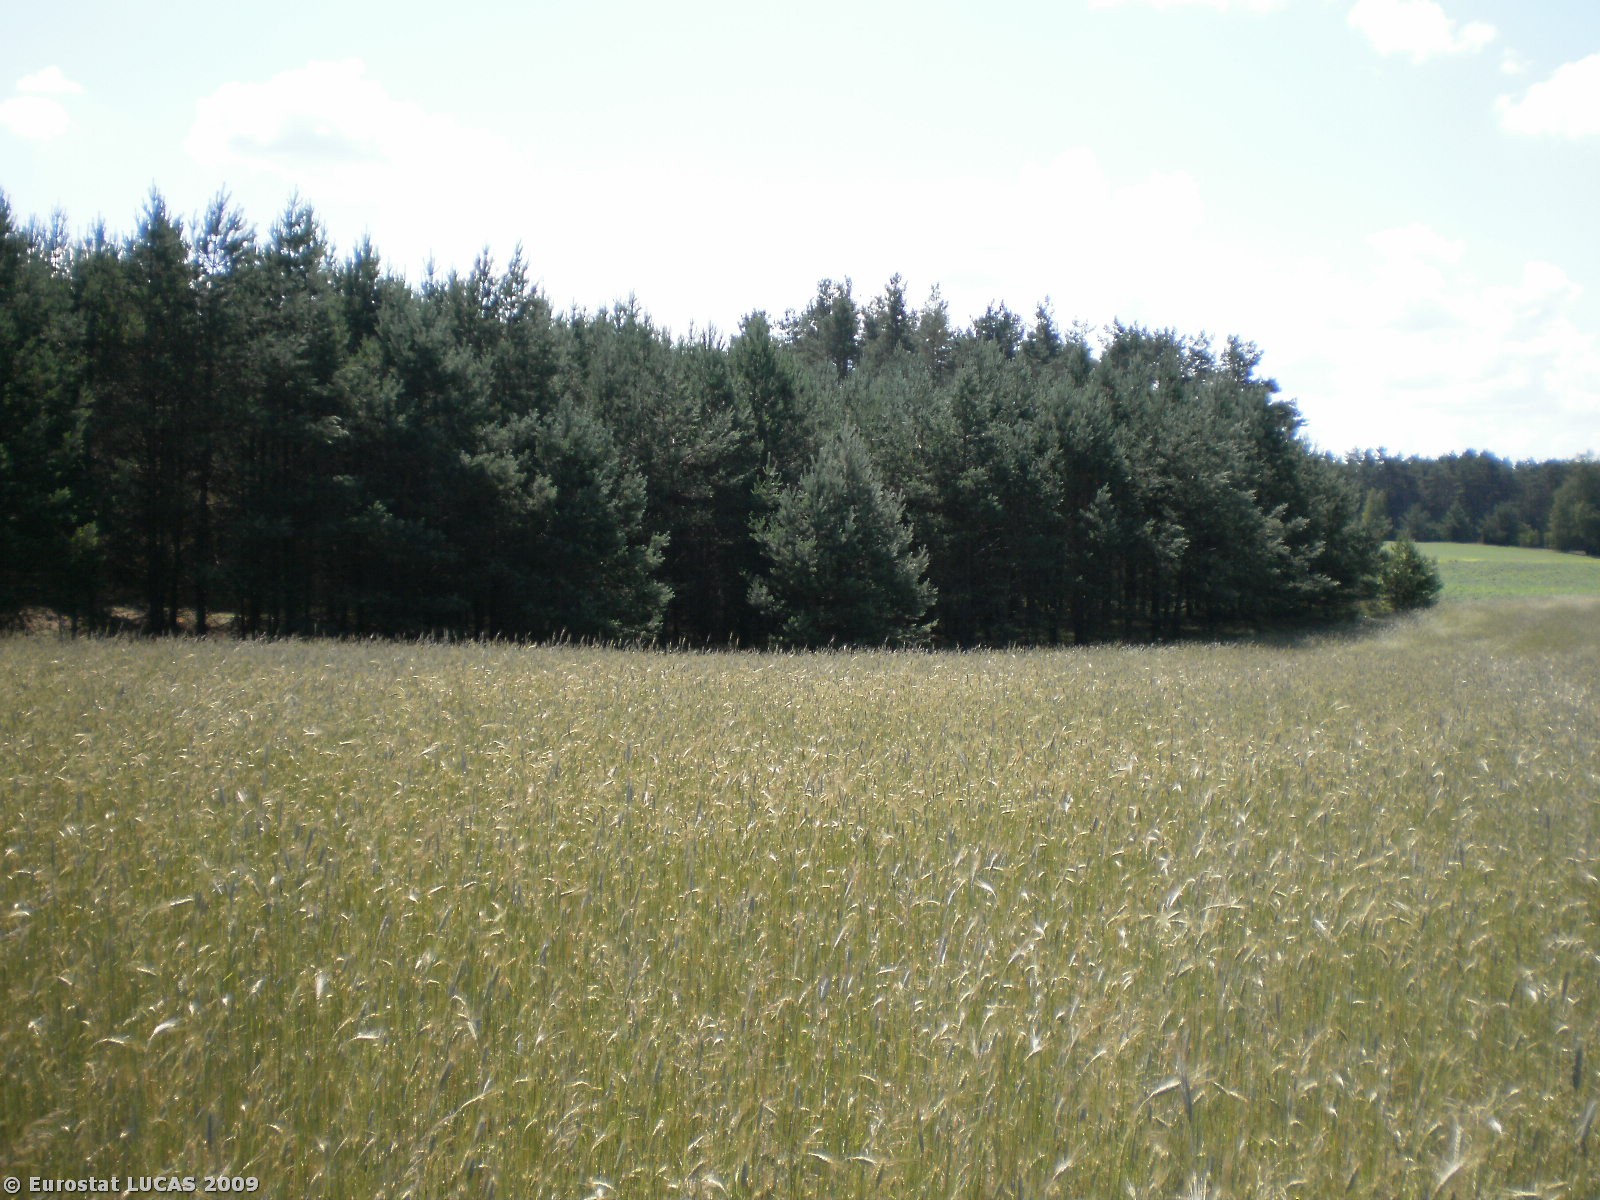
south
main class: Cropland
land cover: Rye
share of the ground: > 75 %
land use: Agriculture (excluding fallow land and kitchen gardens)
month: July
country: PL
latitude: 54.1969
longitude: 17.8148
